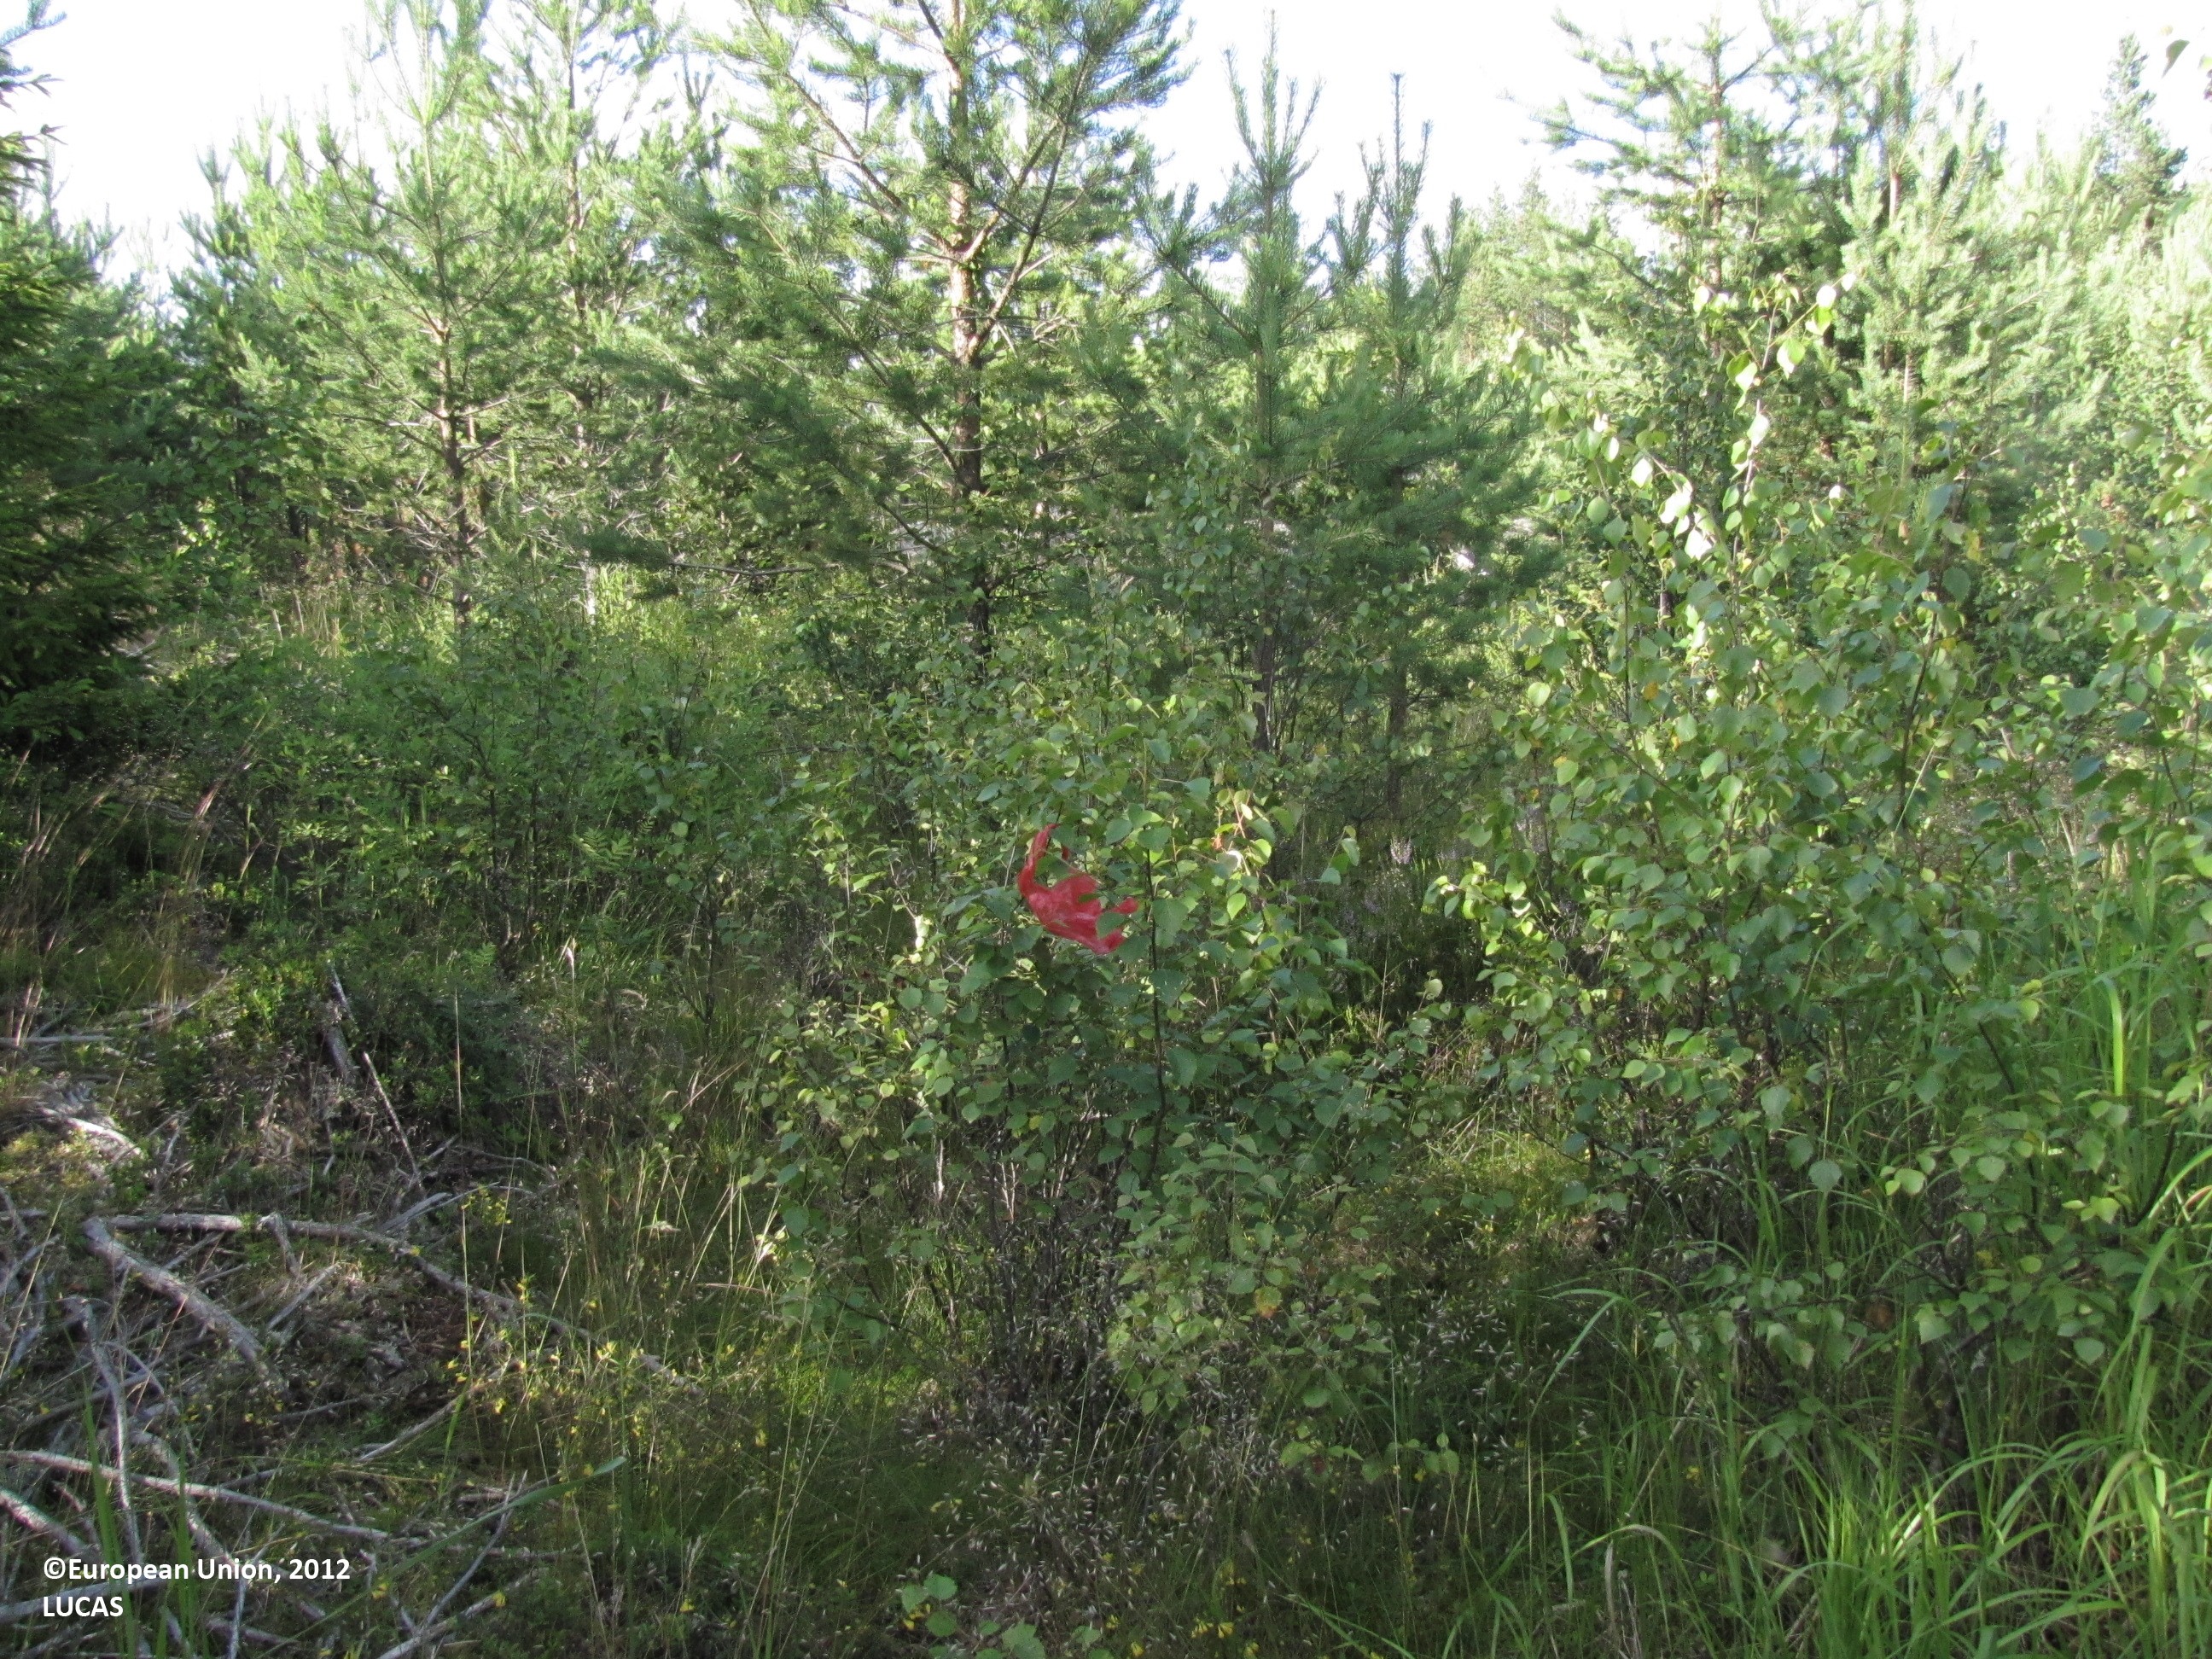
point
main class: Woodland
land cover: Pine dominated mixed woodland
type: boreal forest
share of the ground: > 75 %
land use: Forestry
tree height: < 5 m
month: July
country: FI
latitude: 62.3128
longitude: 23.0879
